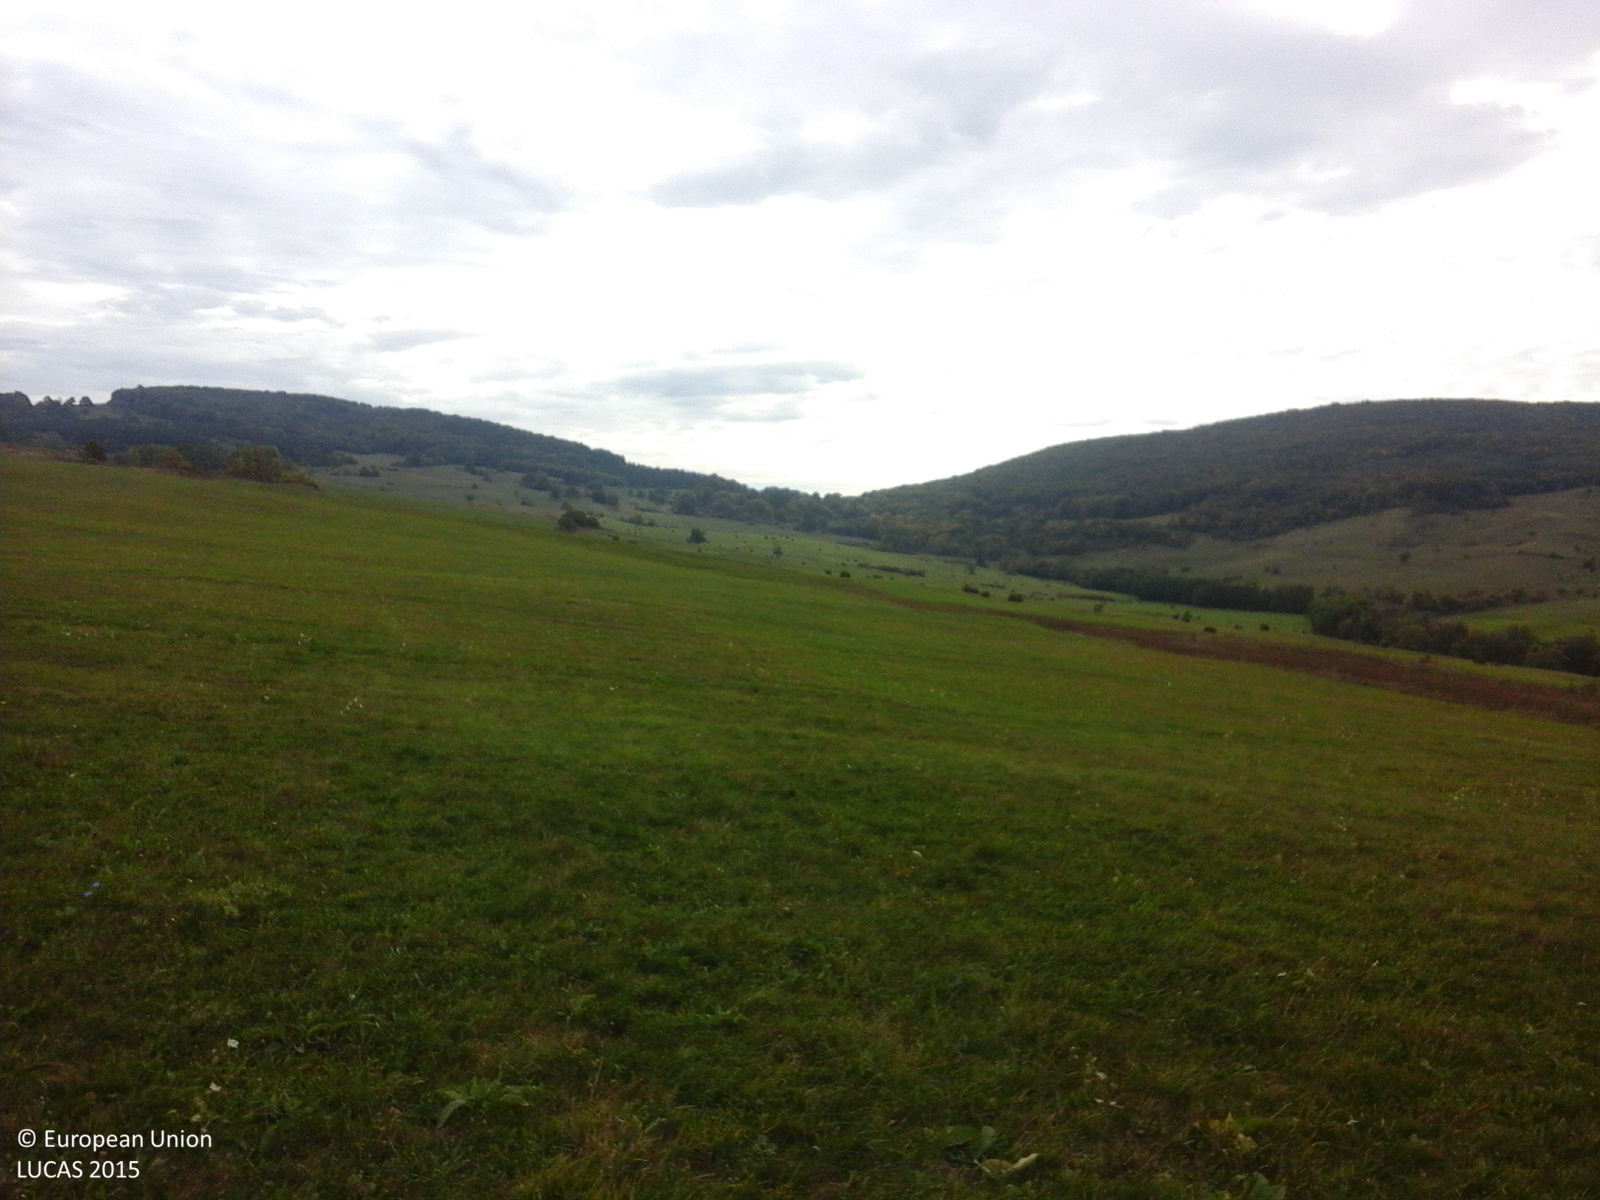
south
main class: Grassland
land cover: Grassland without tree/shrub cover
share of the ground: > 75 %
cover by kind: herbaceous plants 100 %
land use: Agriculture (excluding fallow land and kitchen gardens)
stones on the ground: < 10 %
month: October
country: RO
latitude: 46.2335
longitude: 25.2863
